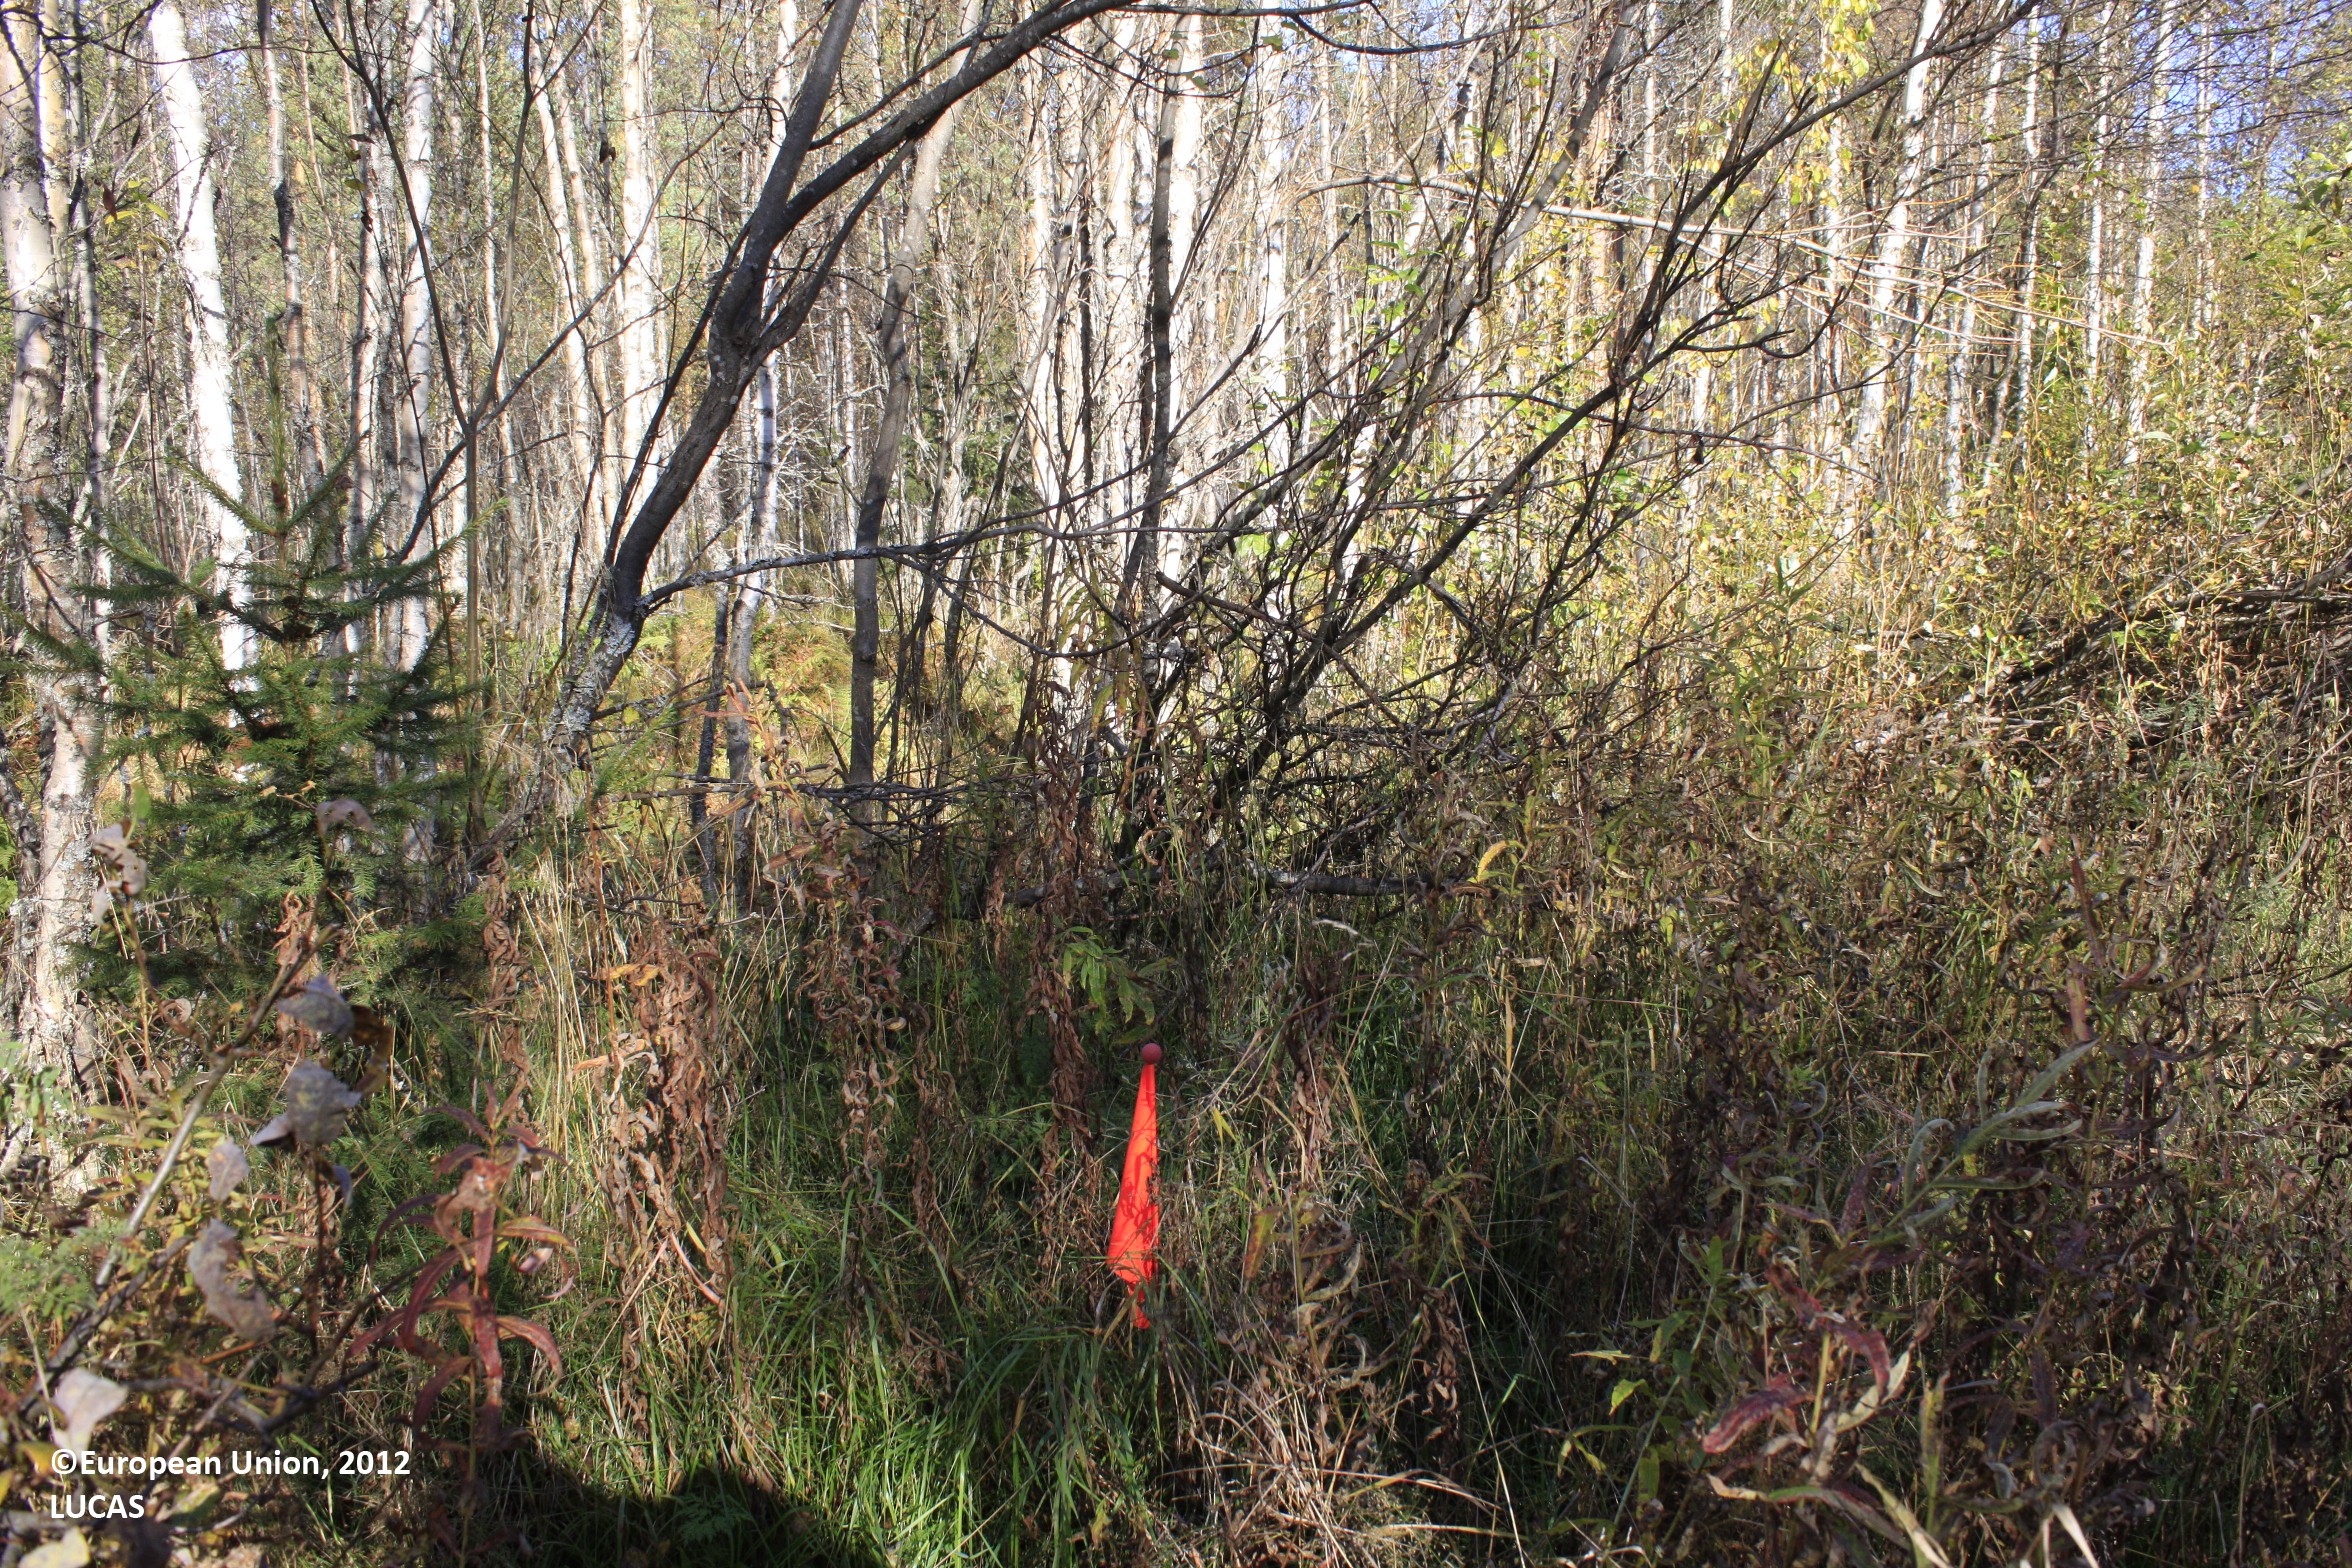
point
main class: Woodland
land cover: Broadleaved woodland
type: boreal forest
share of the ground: 25 - 50 %
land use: Forestry
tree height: > 5 m
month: September
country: FI
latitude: 63.7730
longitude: 25.9074
